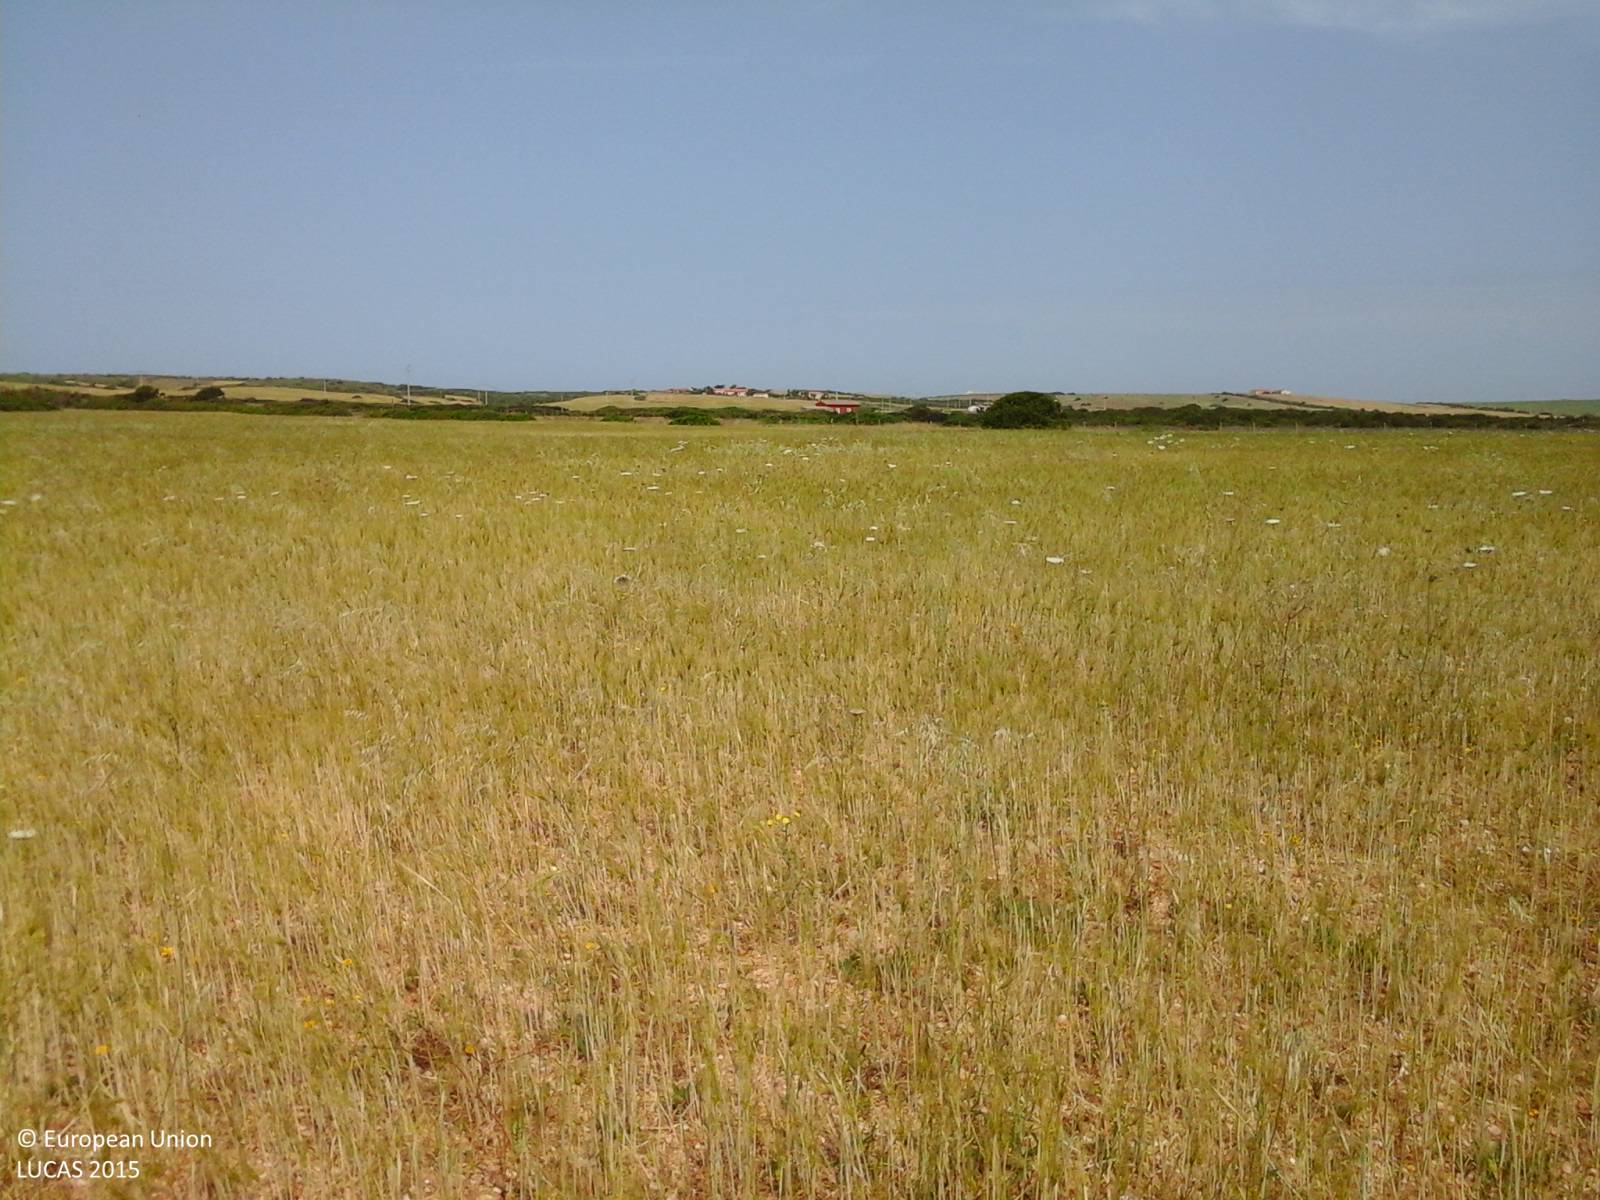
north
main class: Cropland
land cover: Durum wheat
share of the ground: > 75 %
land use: Agriculture (excluding fallow land and kitchen gardens)
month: May
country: IT
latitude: 40.8851
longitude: 8.2399
